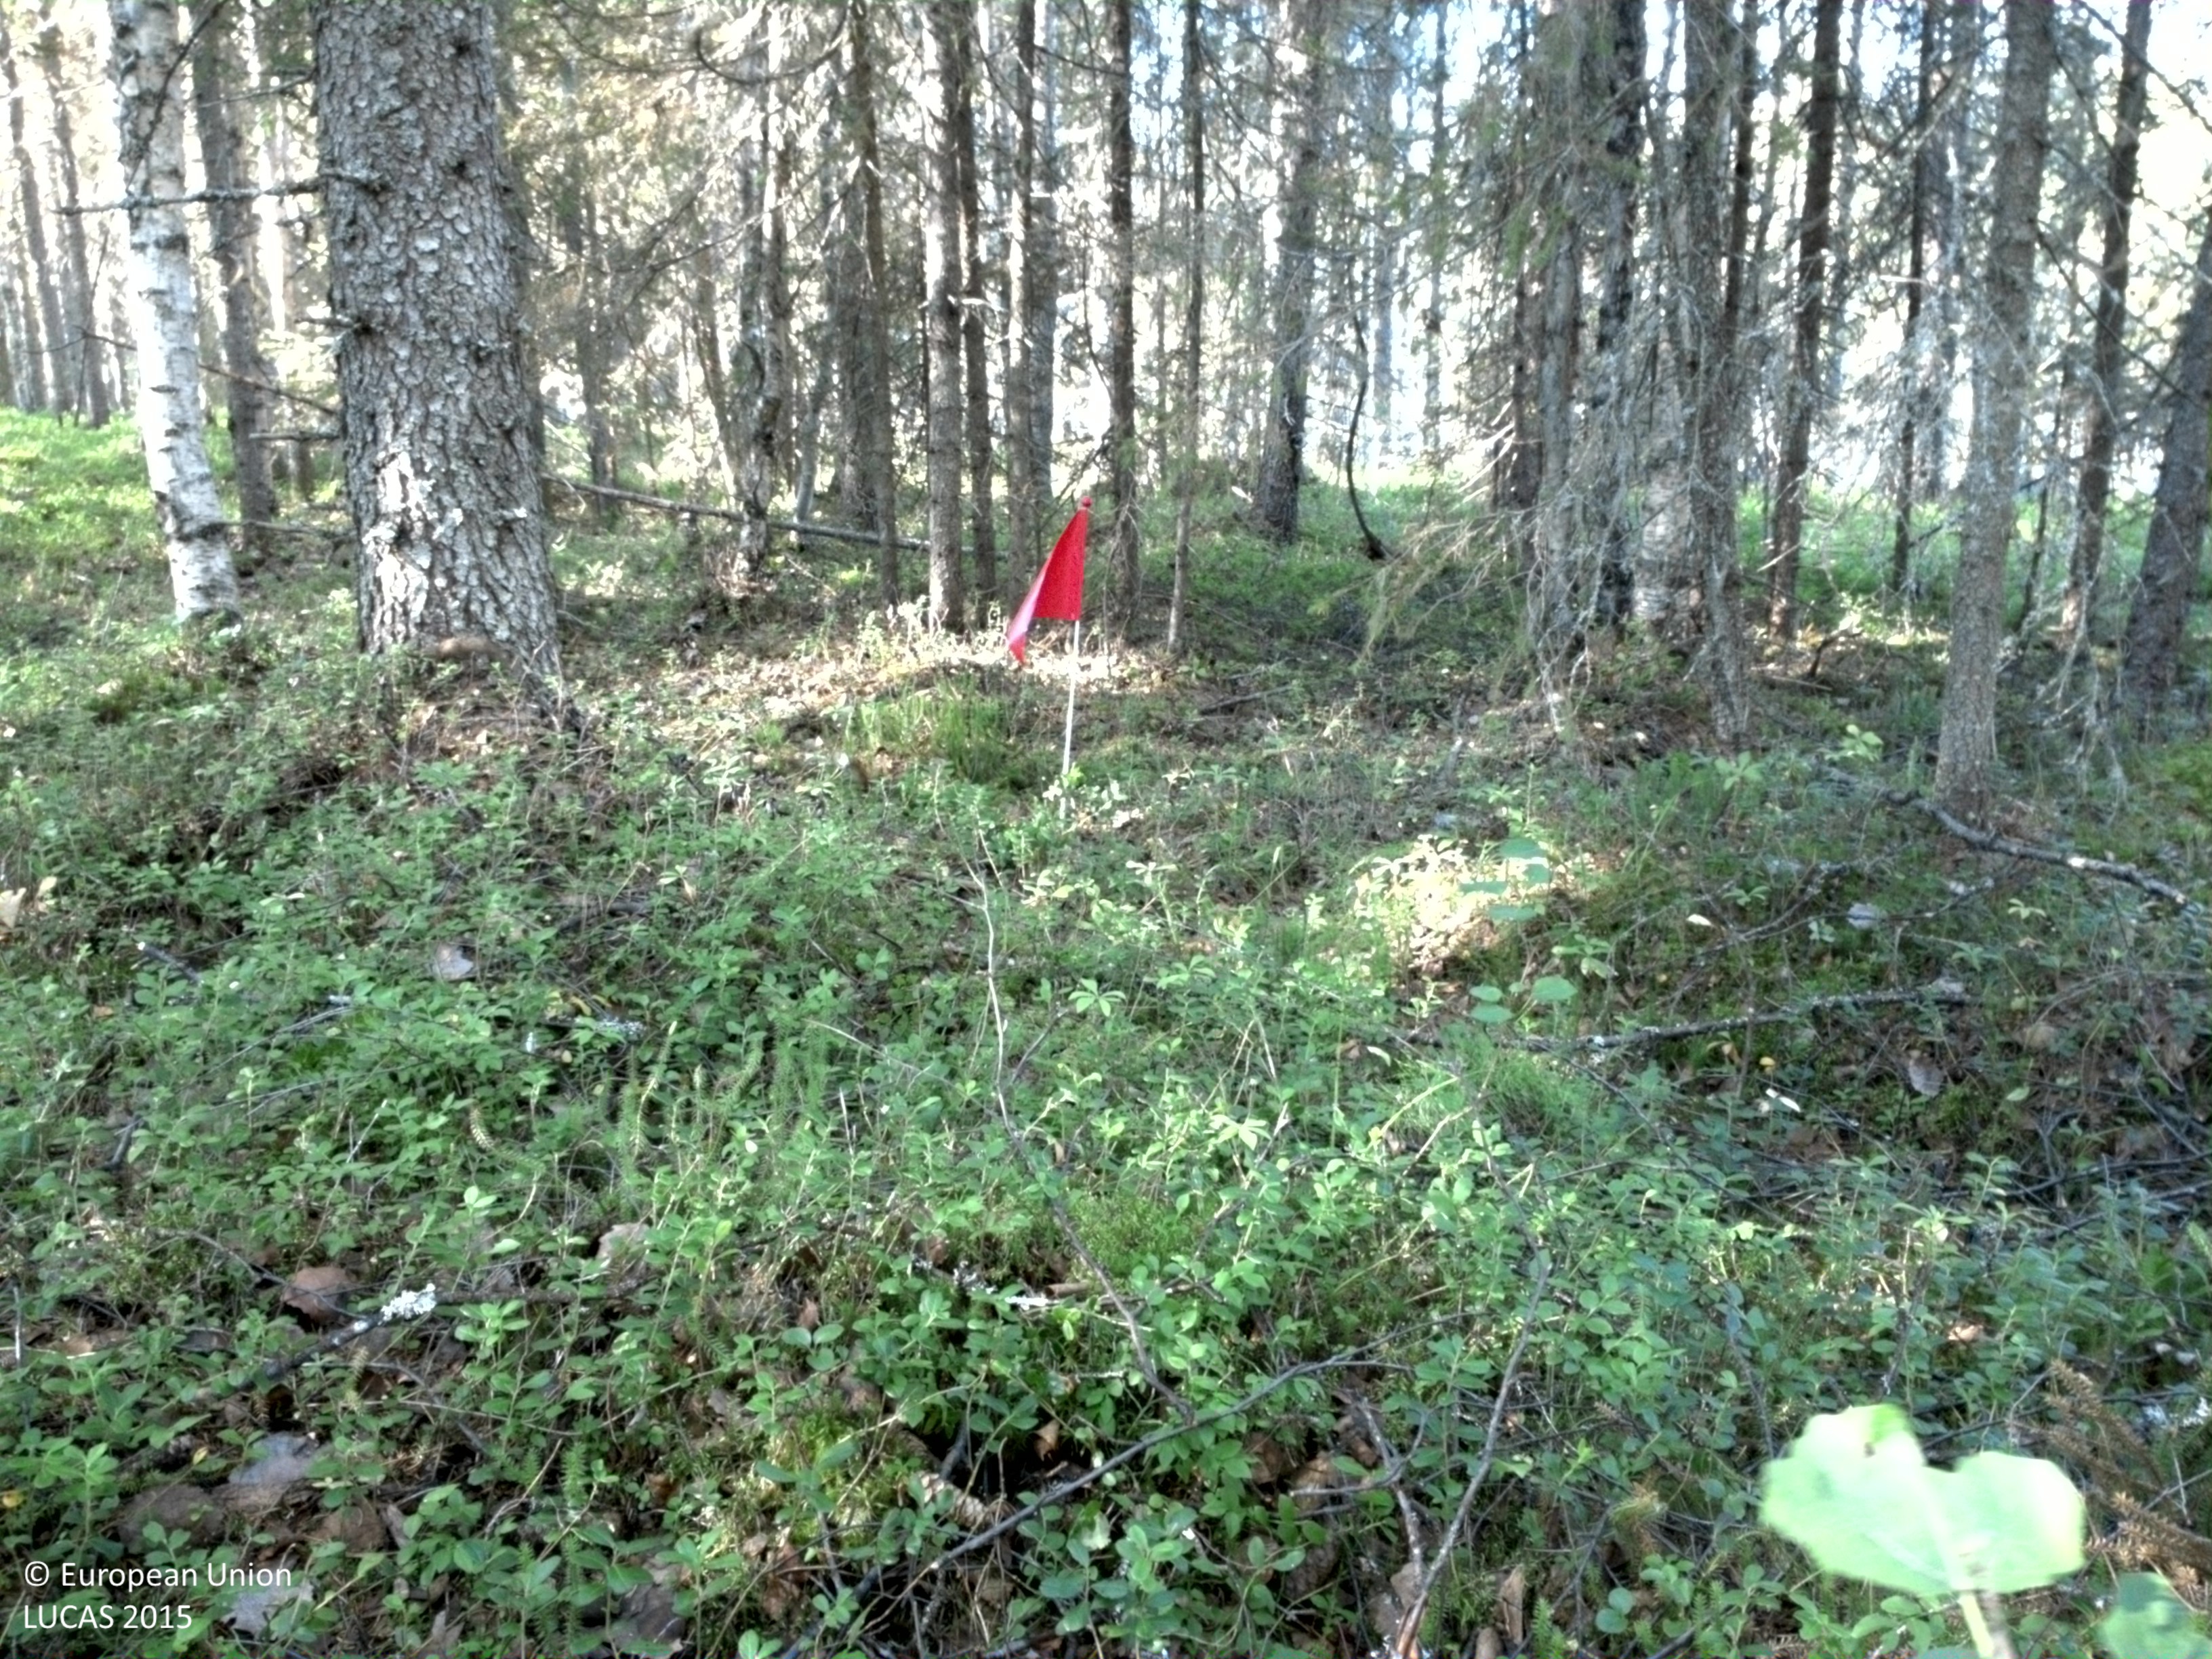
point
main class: Woodland
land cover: Spruce dominated coniferous woodland
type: boreal forest
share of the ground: 50 - 75 %
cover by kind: coniferous forest trees 50 %, shrubs 45 %, broadleaved forest trees 5 %
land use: Forestry
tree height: > 5 m
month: August
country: SE
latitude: 66.1280
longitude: 22.6672
